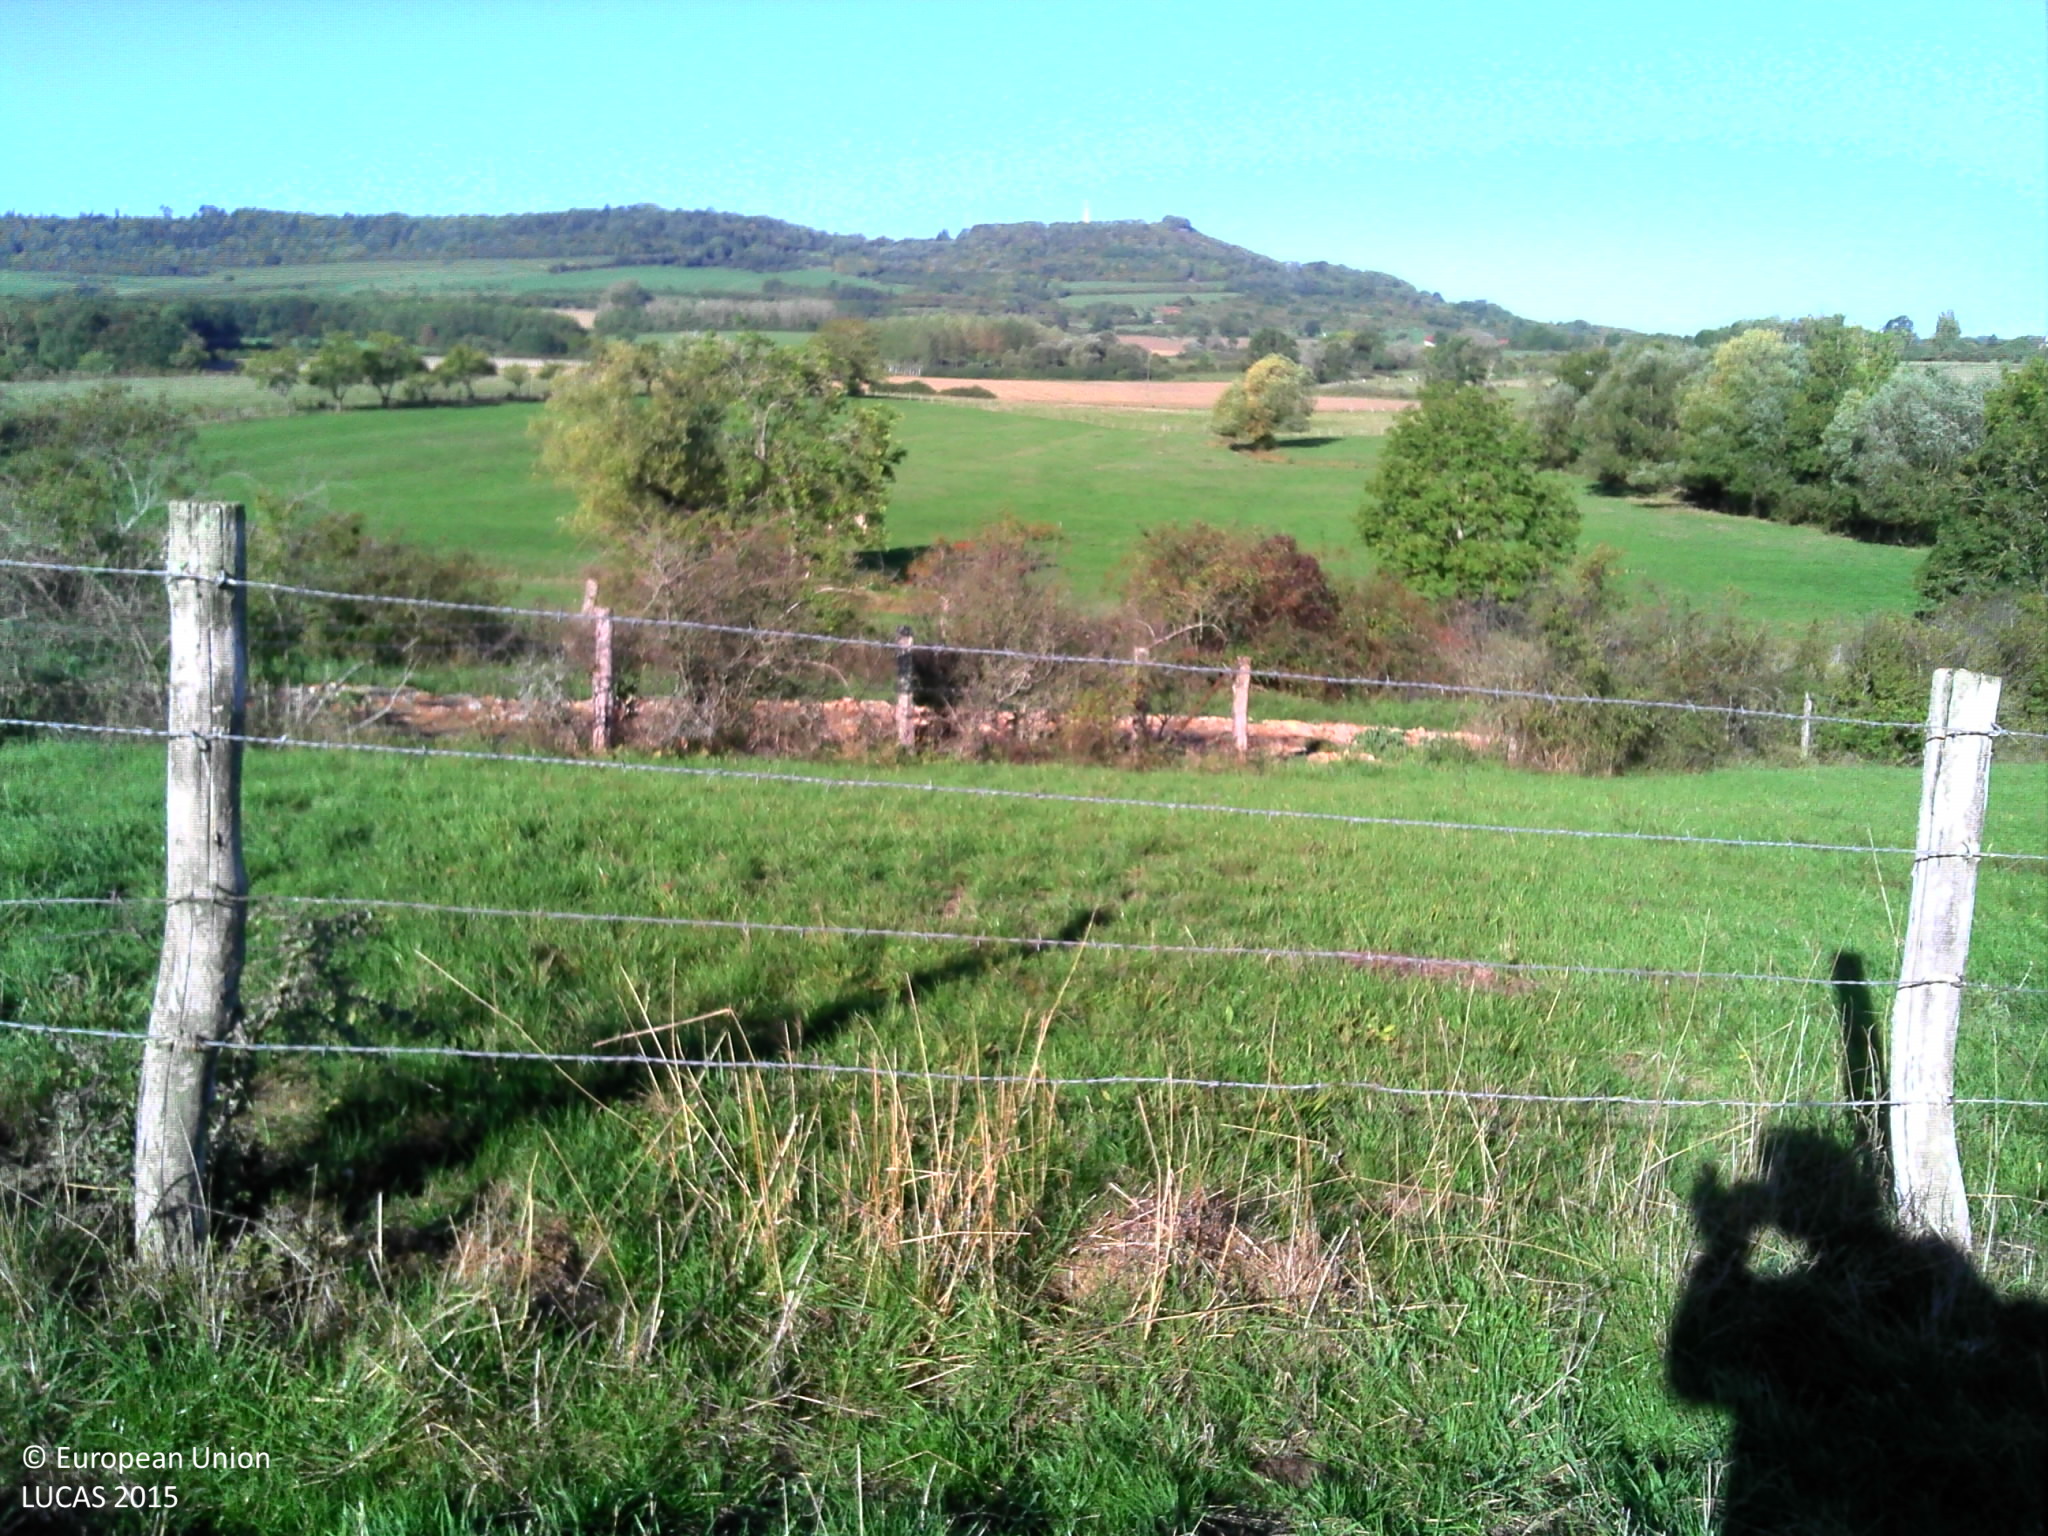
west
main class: Grassland
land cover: Grassland without tree/shrub cover
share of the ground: > 75 %
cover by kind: herbaceous plants 95 %, consolidated bare surface 5 %
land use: Agriculture (excluding fallow land and kitchen gardens)
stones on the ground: < 10 %
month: September
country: FR
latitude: 48.4256
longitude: 6.1217
